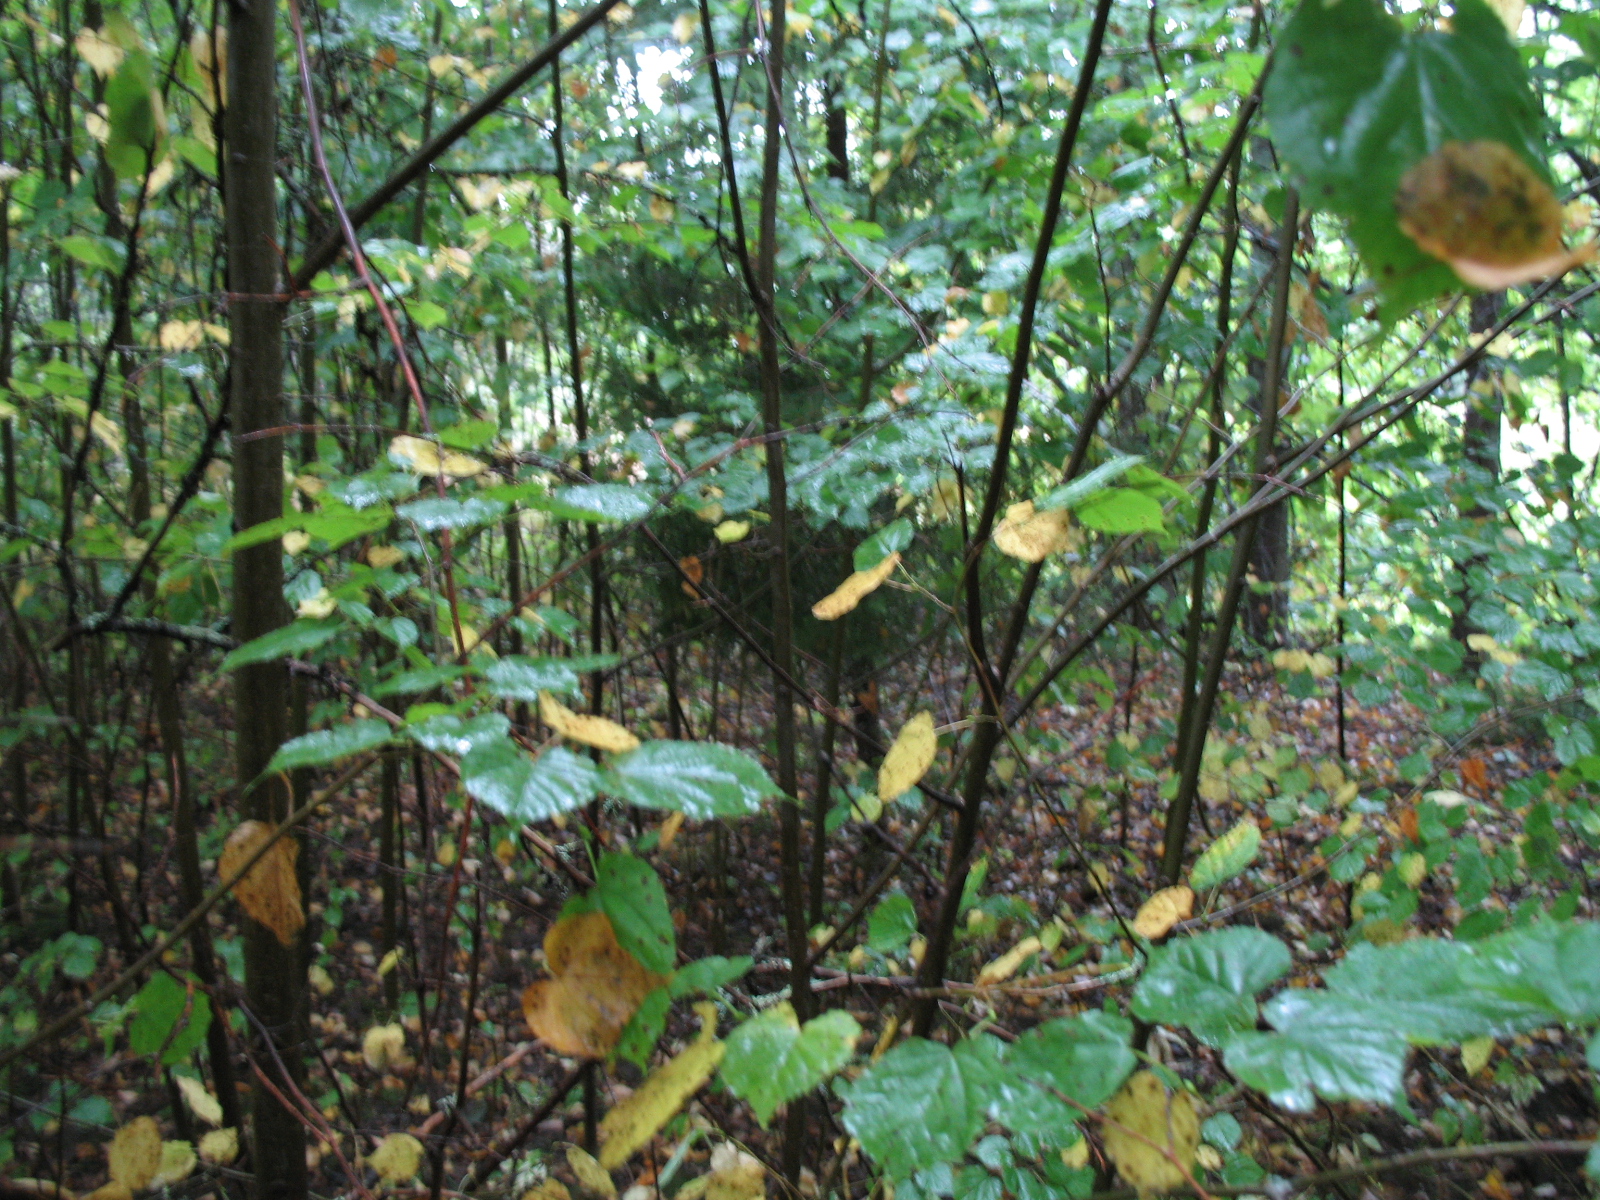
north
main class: Woodland
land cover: Broadleaved woodland
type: non-riverine alder, birch or aspen forest
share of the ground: > 75 %
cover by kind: broadleaved forest trees 80 %, coniferous forest trees 10 %, herbaceous plants 10 %
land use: Forestry
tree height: > 5 m
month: September
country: LV
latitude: 56.1252
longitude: 26.1789
